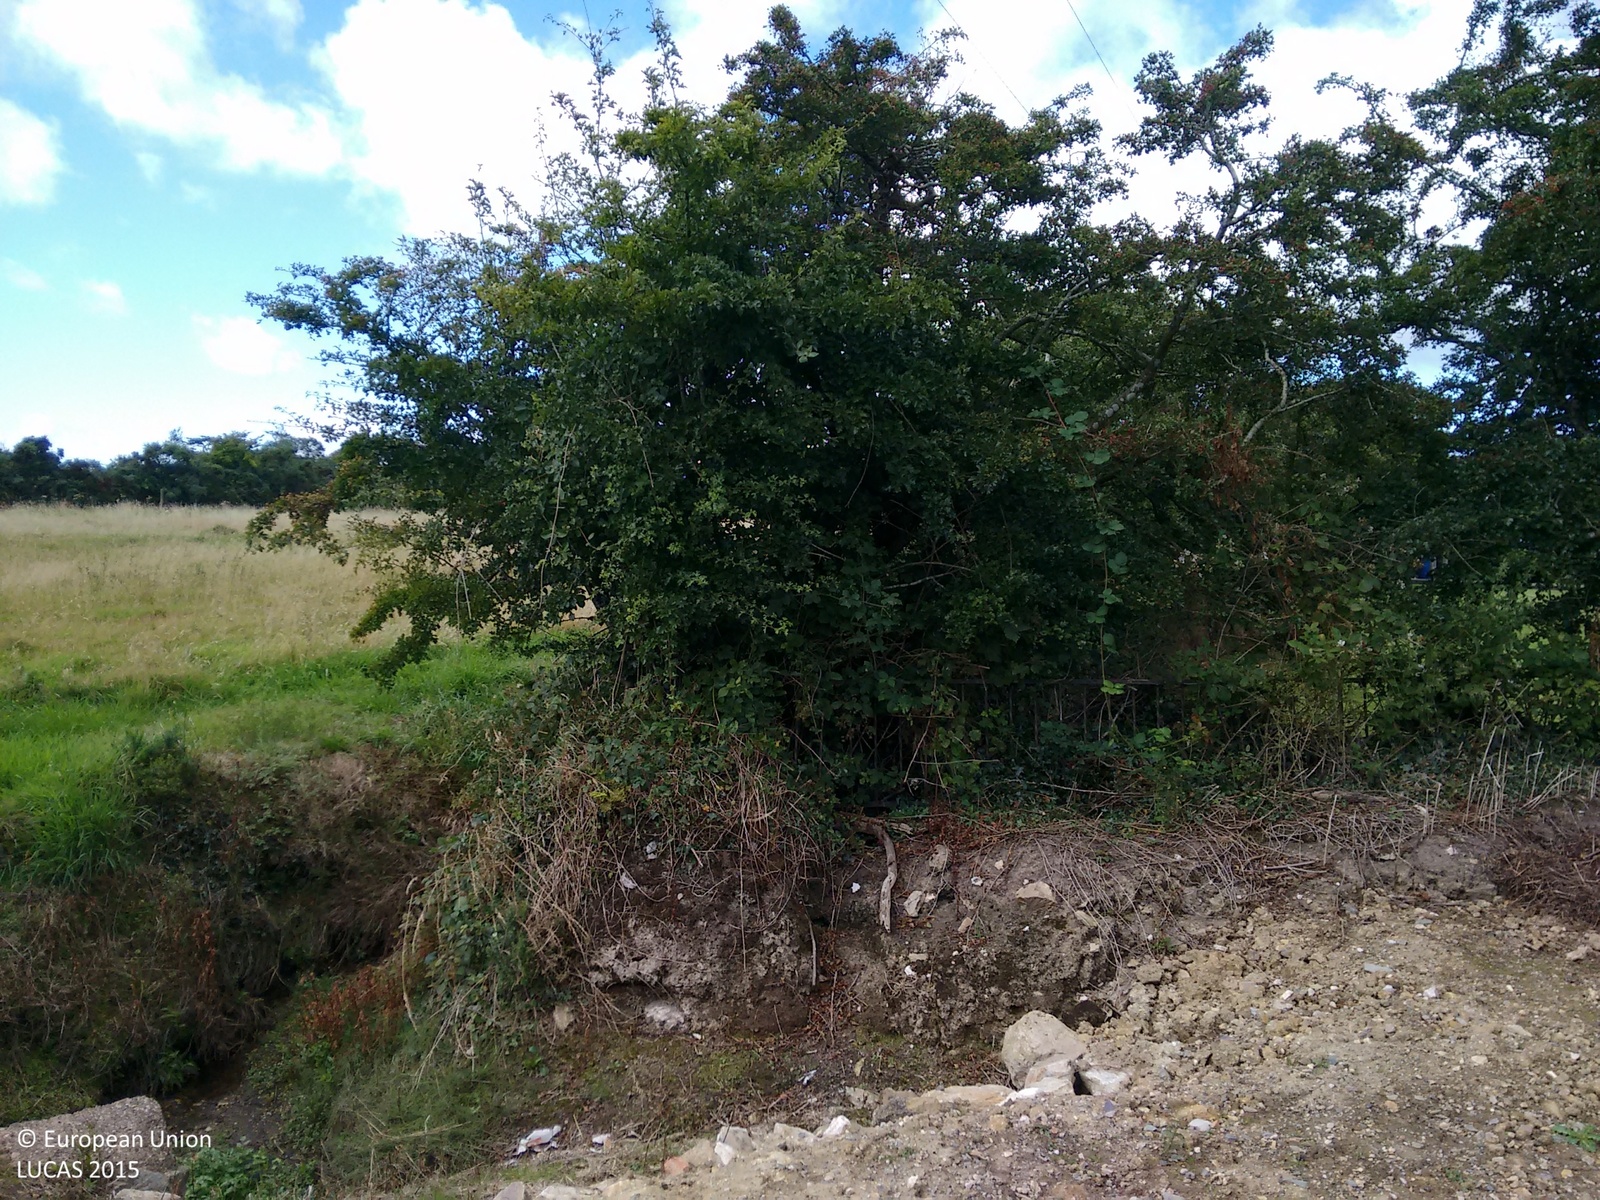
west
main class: Grassland
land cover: Grassland with sparse tree/shrub cover
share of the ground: > 75 %
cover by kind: herbaceous plants 95 %, broadleaved forest trees 5 %
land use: Residential
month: August
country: IE
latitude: 52.2903
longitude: -6.5346
